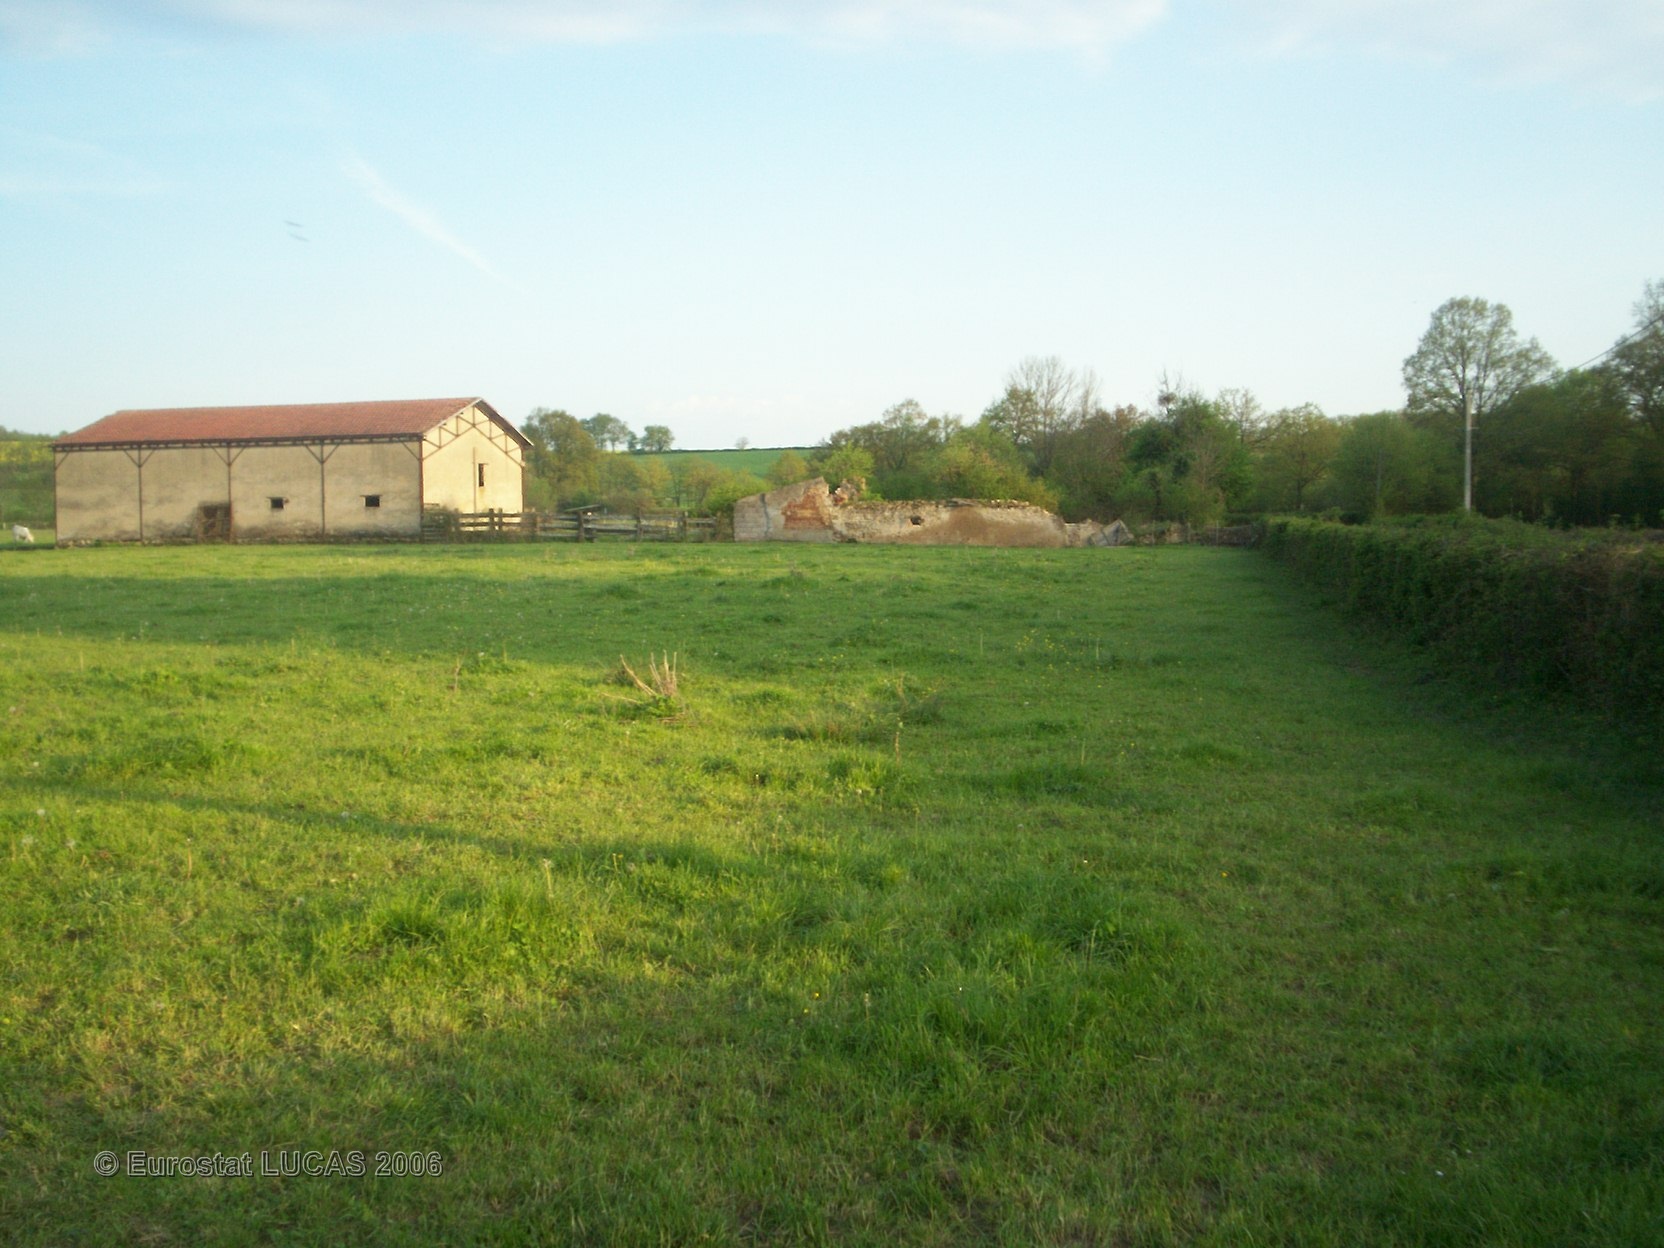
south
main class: Grassland
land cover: Grassland without tree/shrub cover
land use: Agriculture (excluding fallow land and kitchen gardens)
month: May
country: FR
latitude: 46.2375
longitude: 3.1123
